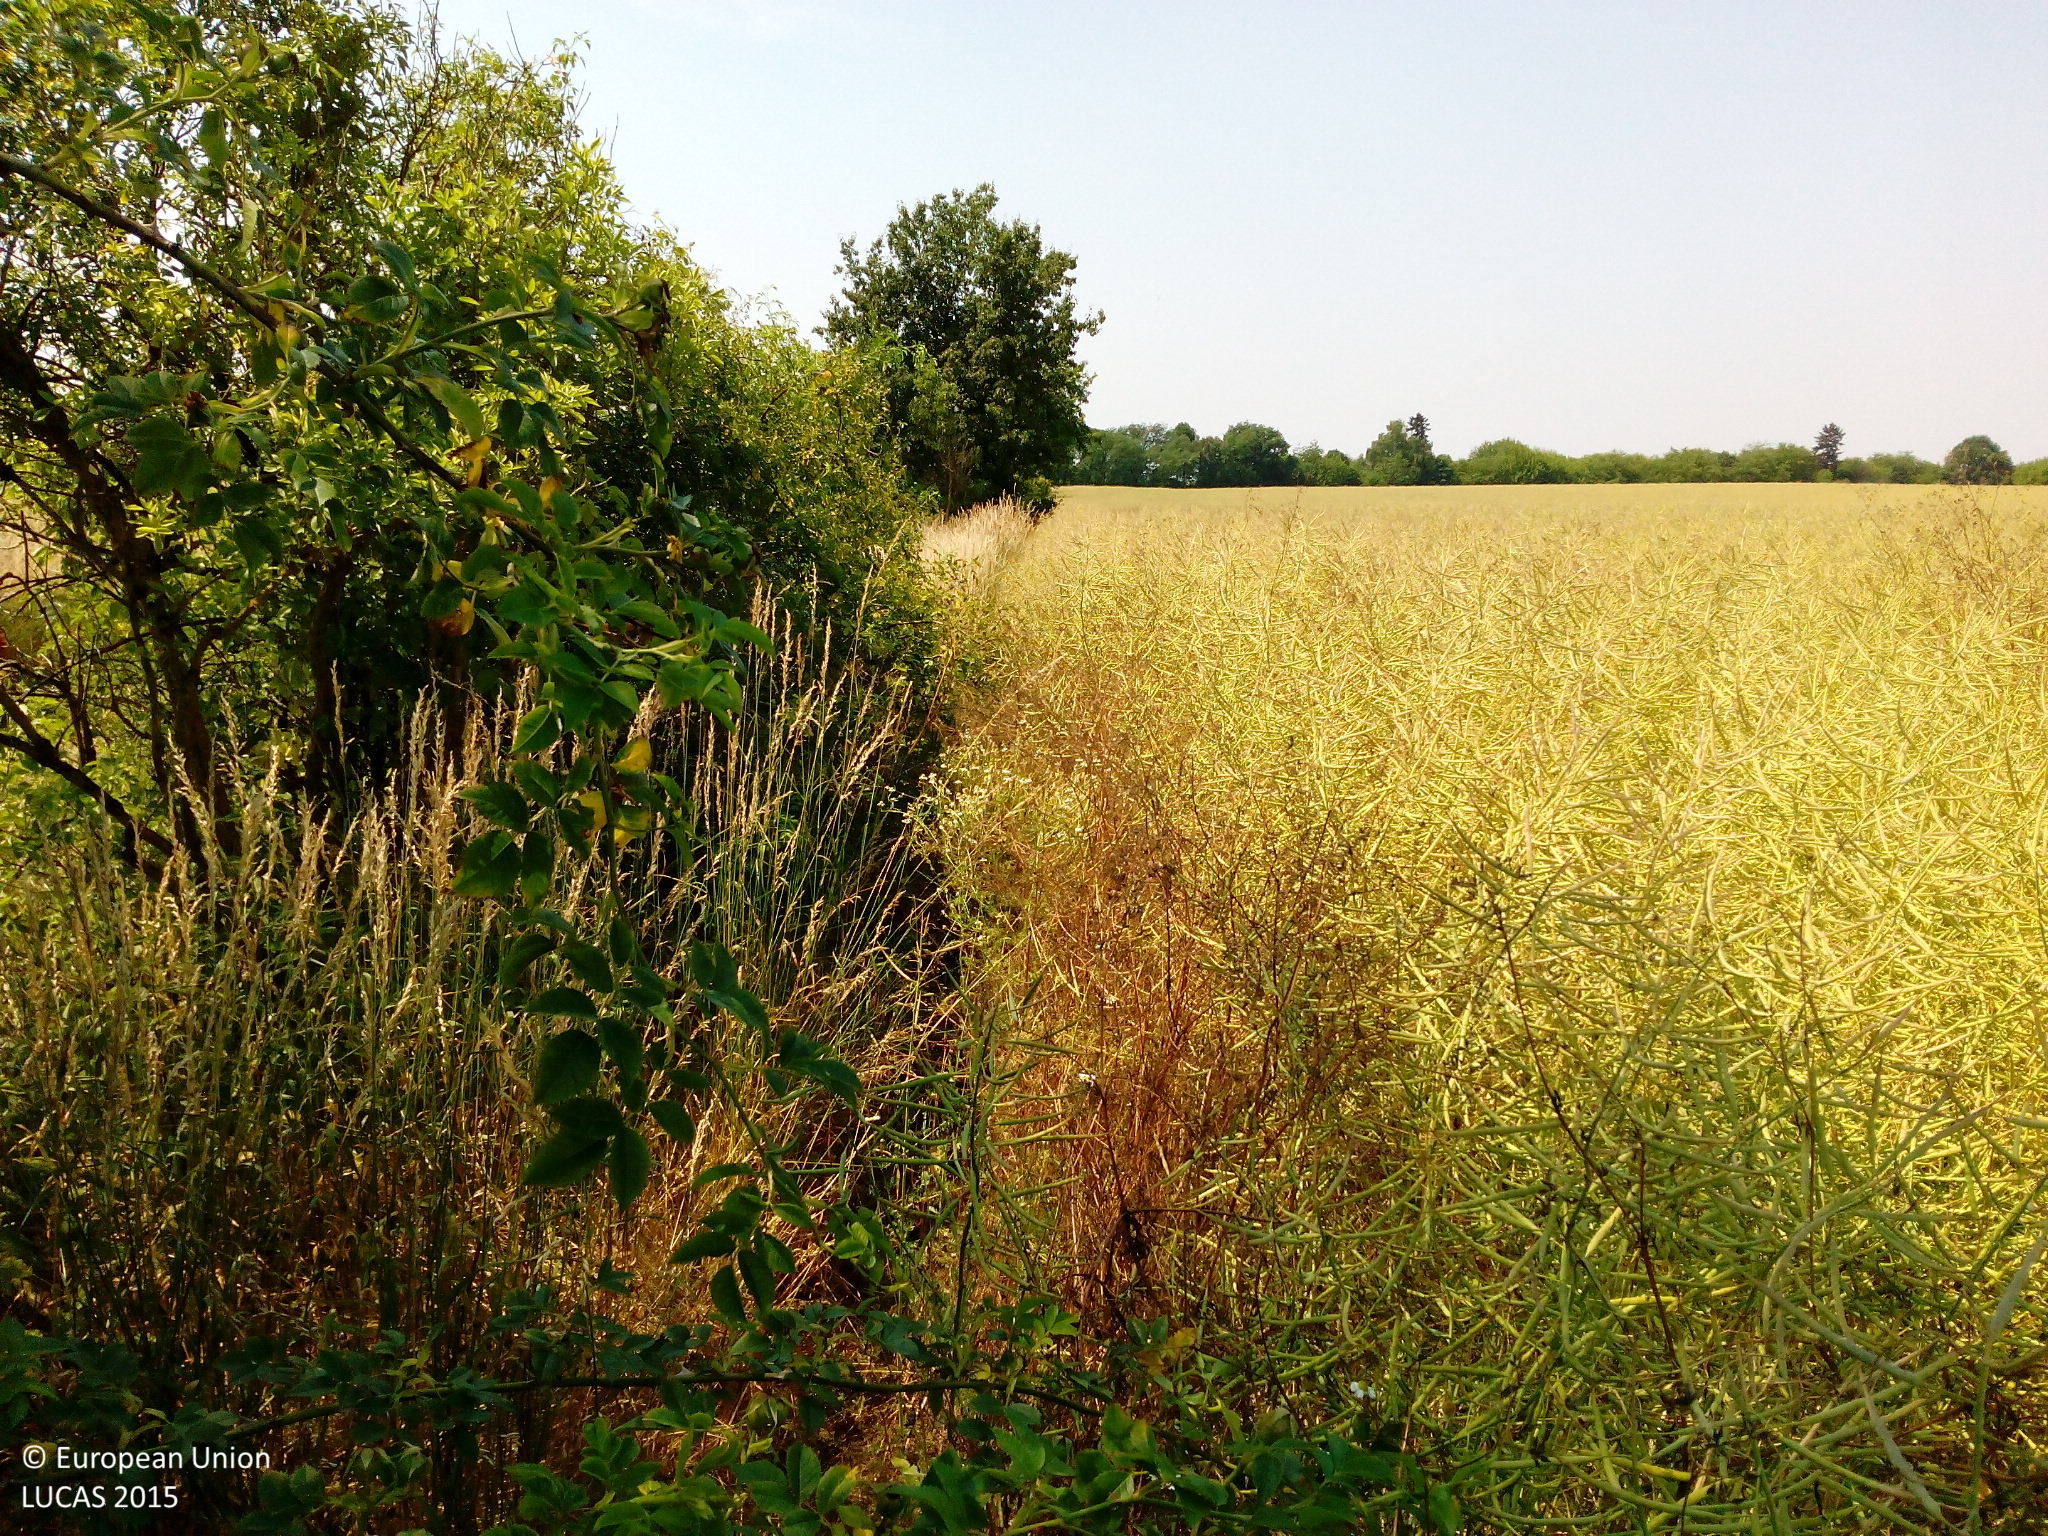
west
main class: Cropland
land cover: Rape and turnip rape
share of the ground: > 75 %
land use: Agriculture (excluding fallow land and kitchen gardens)
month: July
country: DE
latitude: 52.4495
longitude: 14.1356
